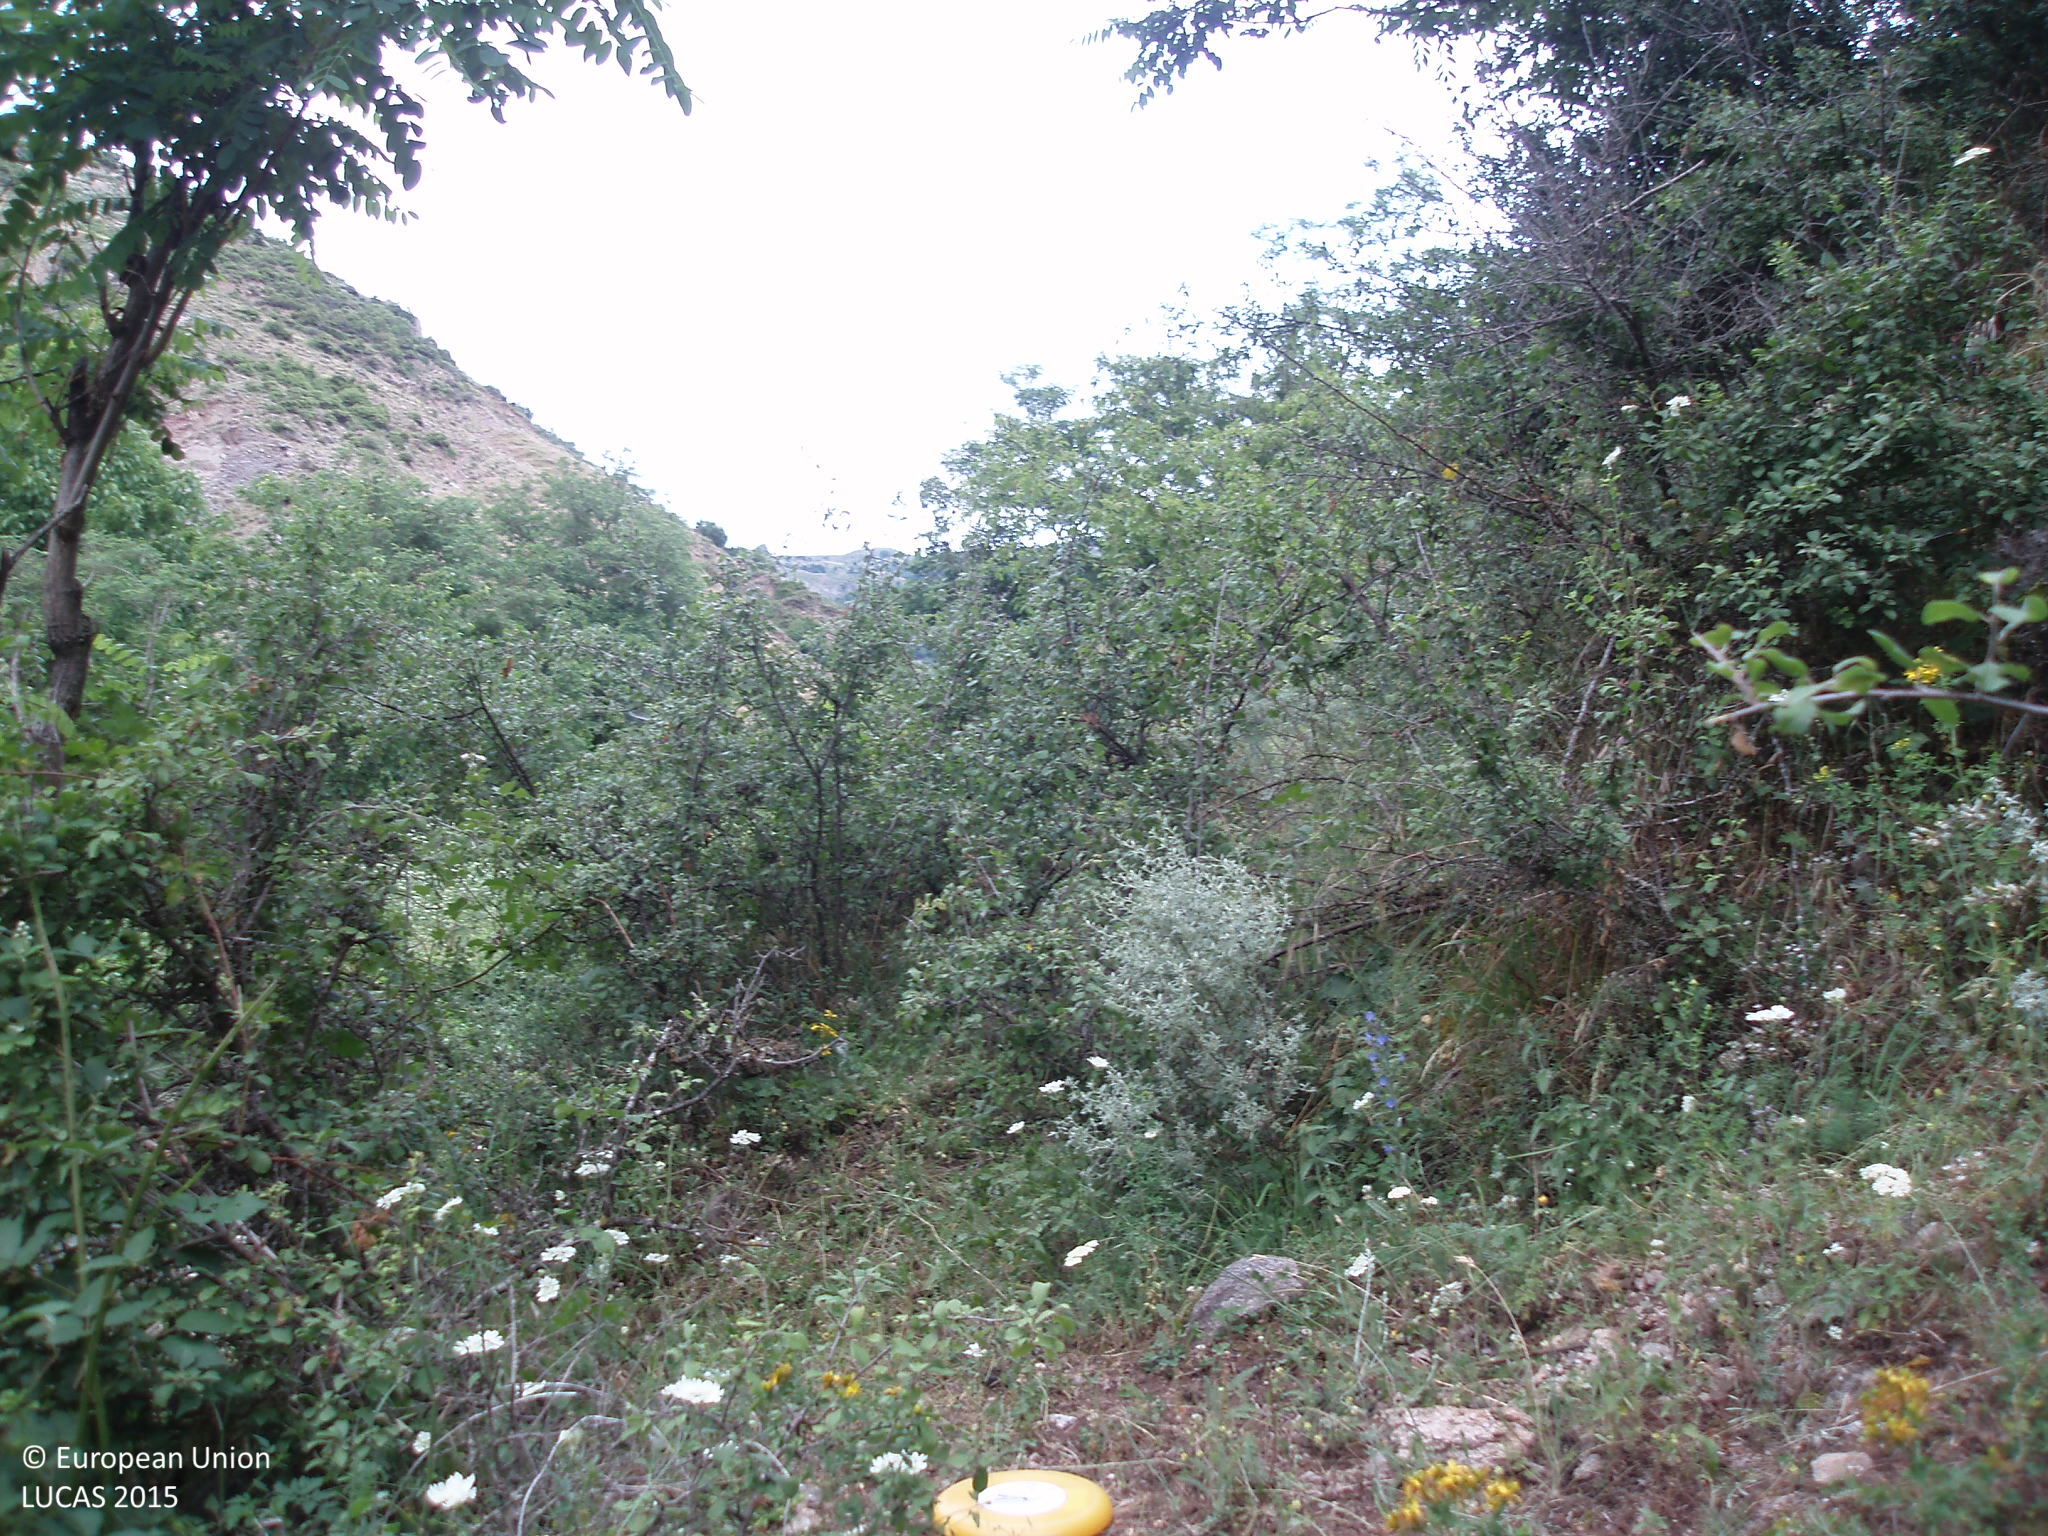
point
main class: Woodland
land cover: Broadleaved woodland
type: mesophytic deciduous forest
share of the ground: 50 - 75 %
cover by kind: broadleaved forest trees 55 %, shrubs 40 %, unconsolidated bare surface 5 %
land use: Forestry
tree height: > 5 m
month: June
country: BG
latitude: 41.7154
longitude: 23.7198
